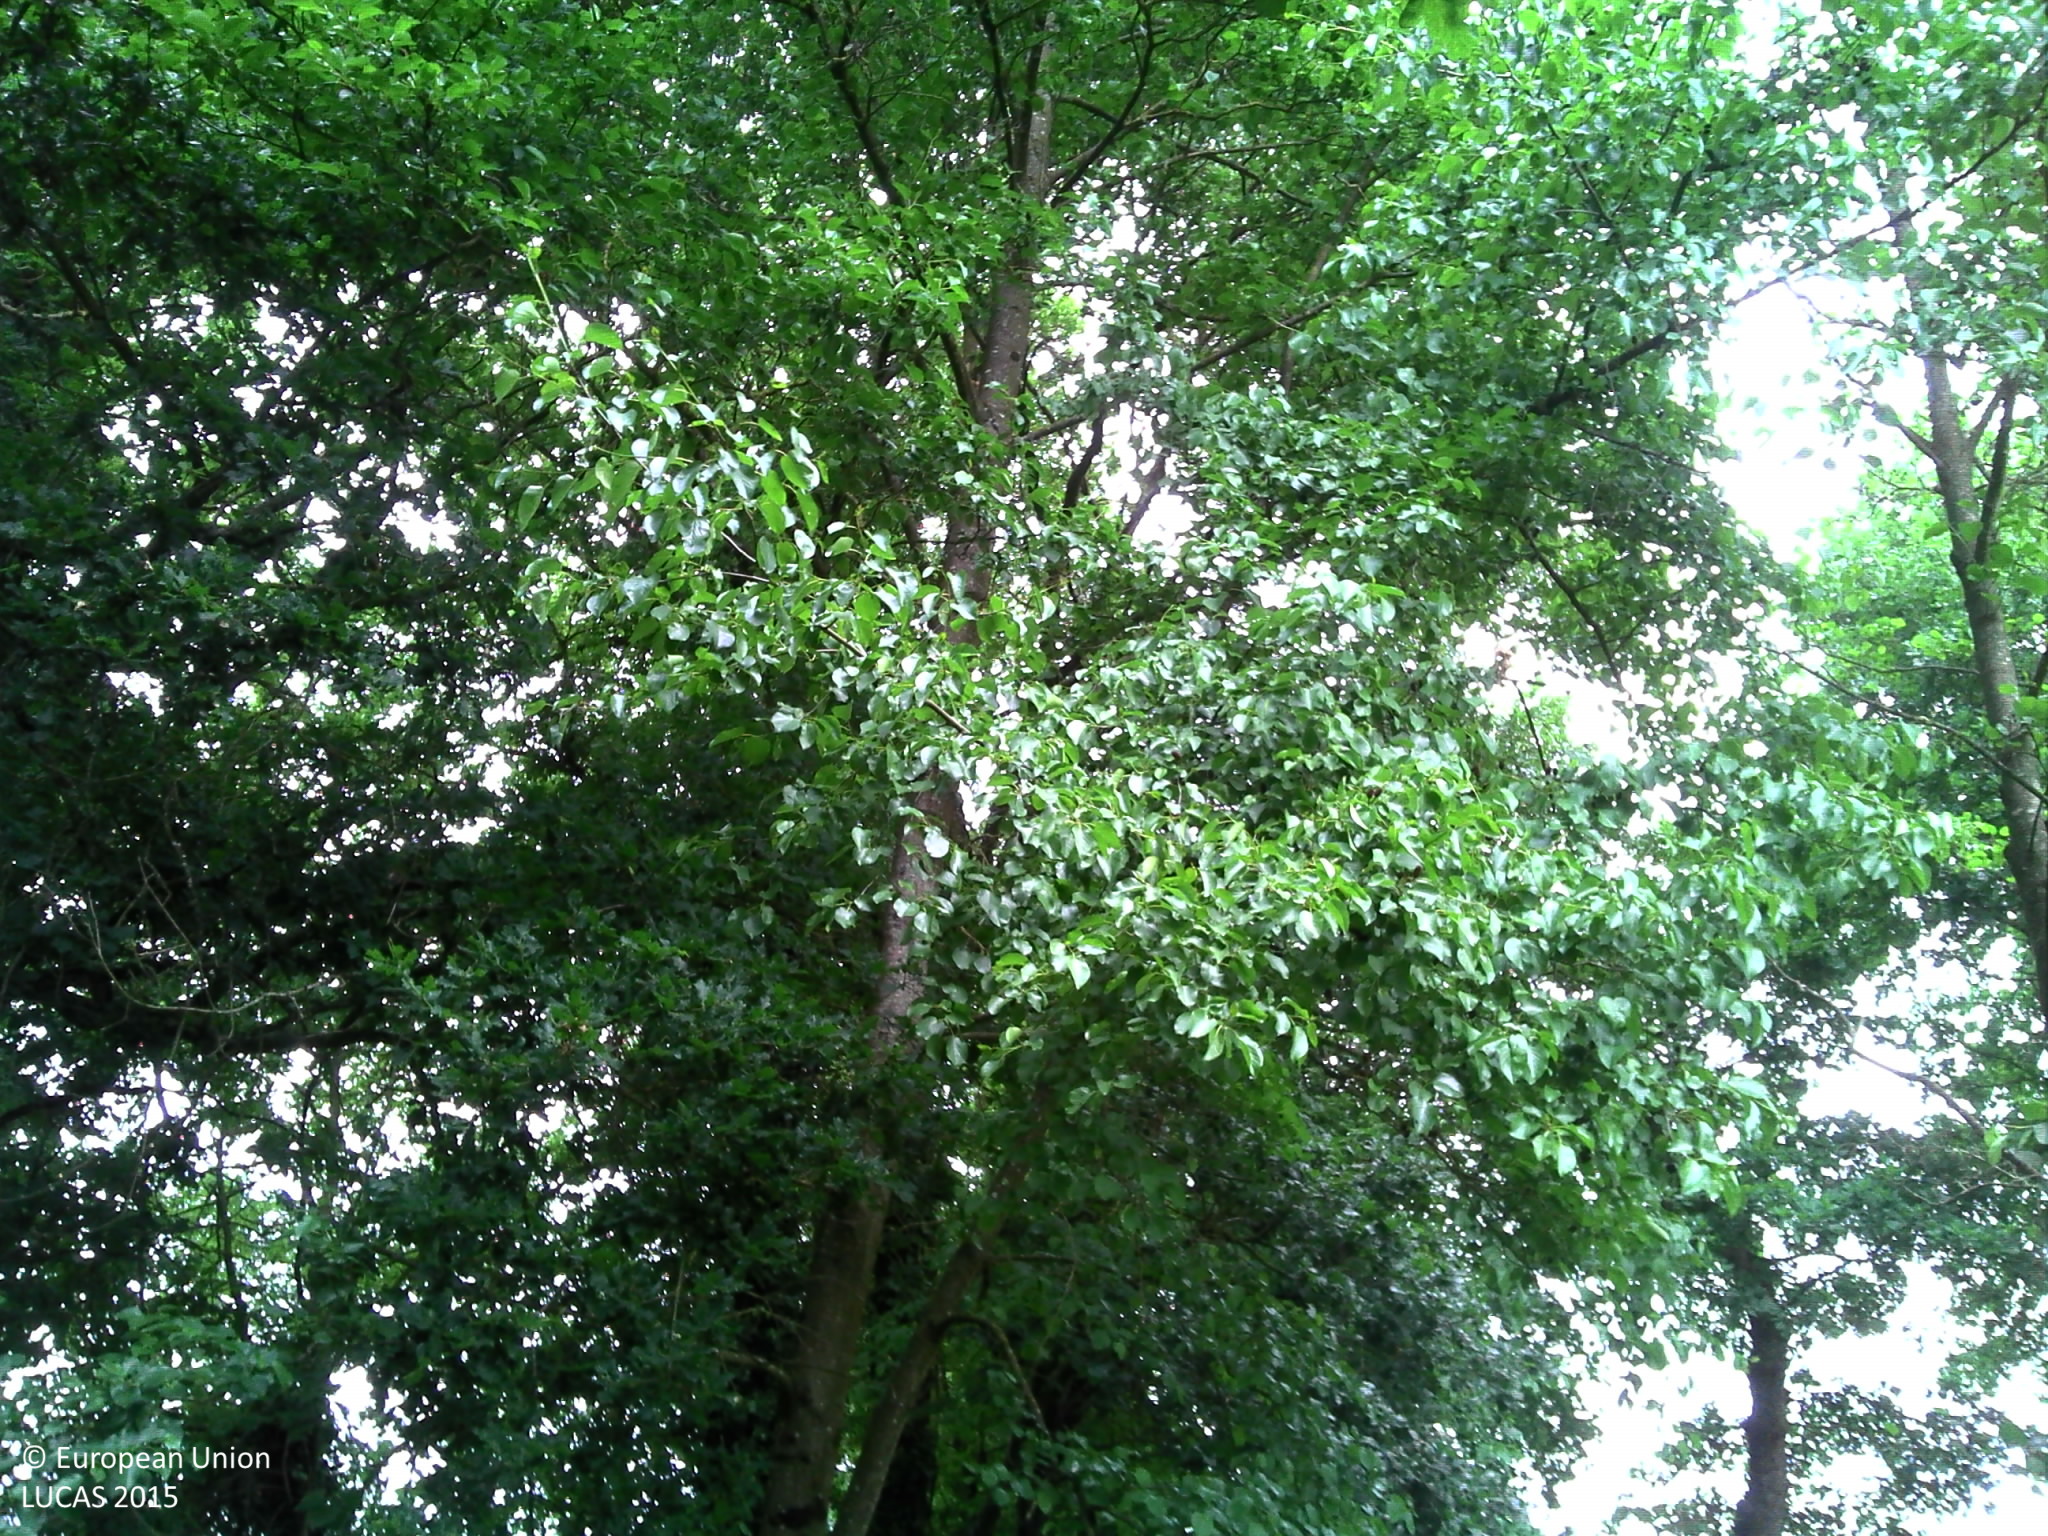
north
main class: Woodland
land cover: Broadleaved woodland
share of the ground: 25 - 50 %
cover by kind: broadleaved forest trees 50 %, herbaceous plants 50 %
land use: Agriculture (excluding fallow land and kitchen gardens)
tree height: > 5 m
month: June
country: FR
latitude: 48.2033
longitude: -1.9877
